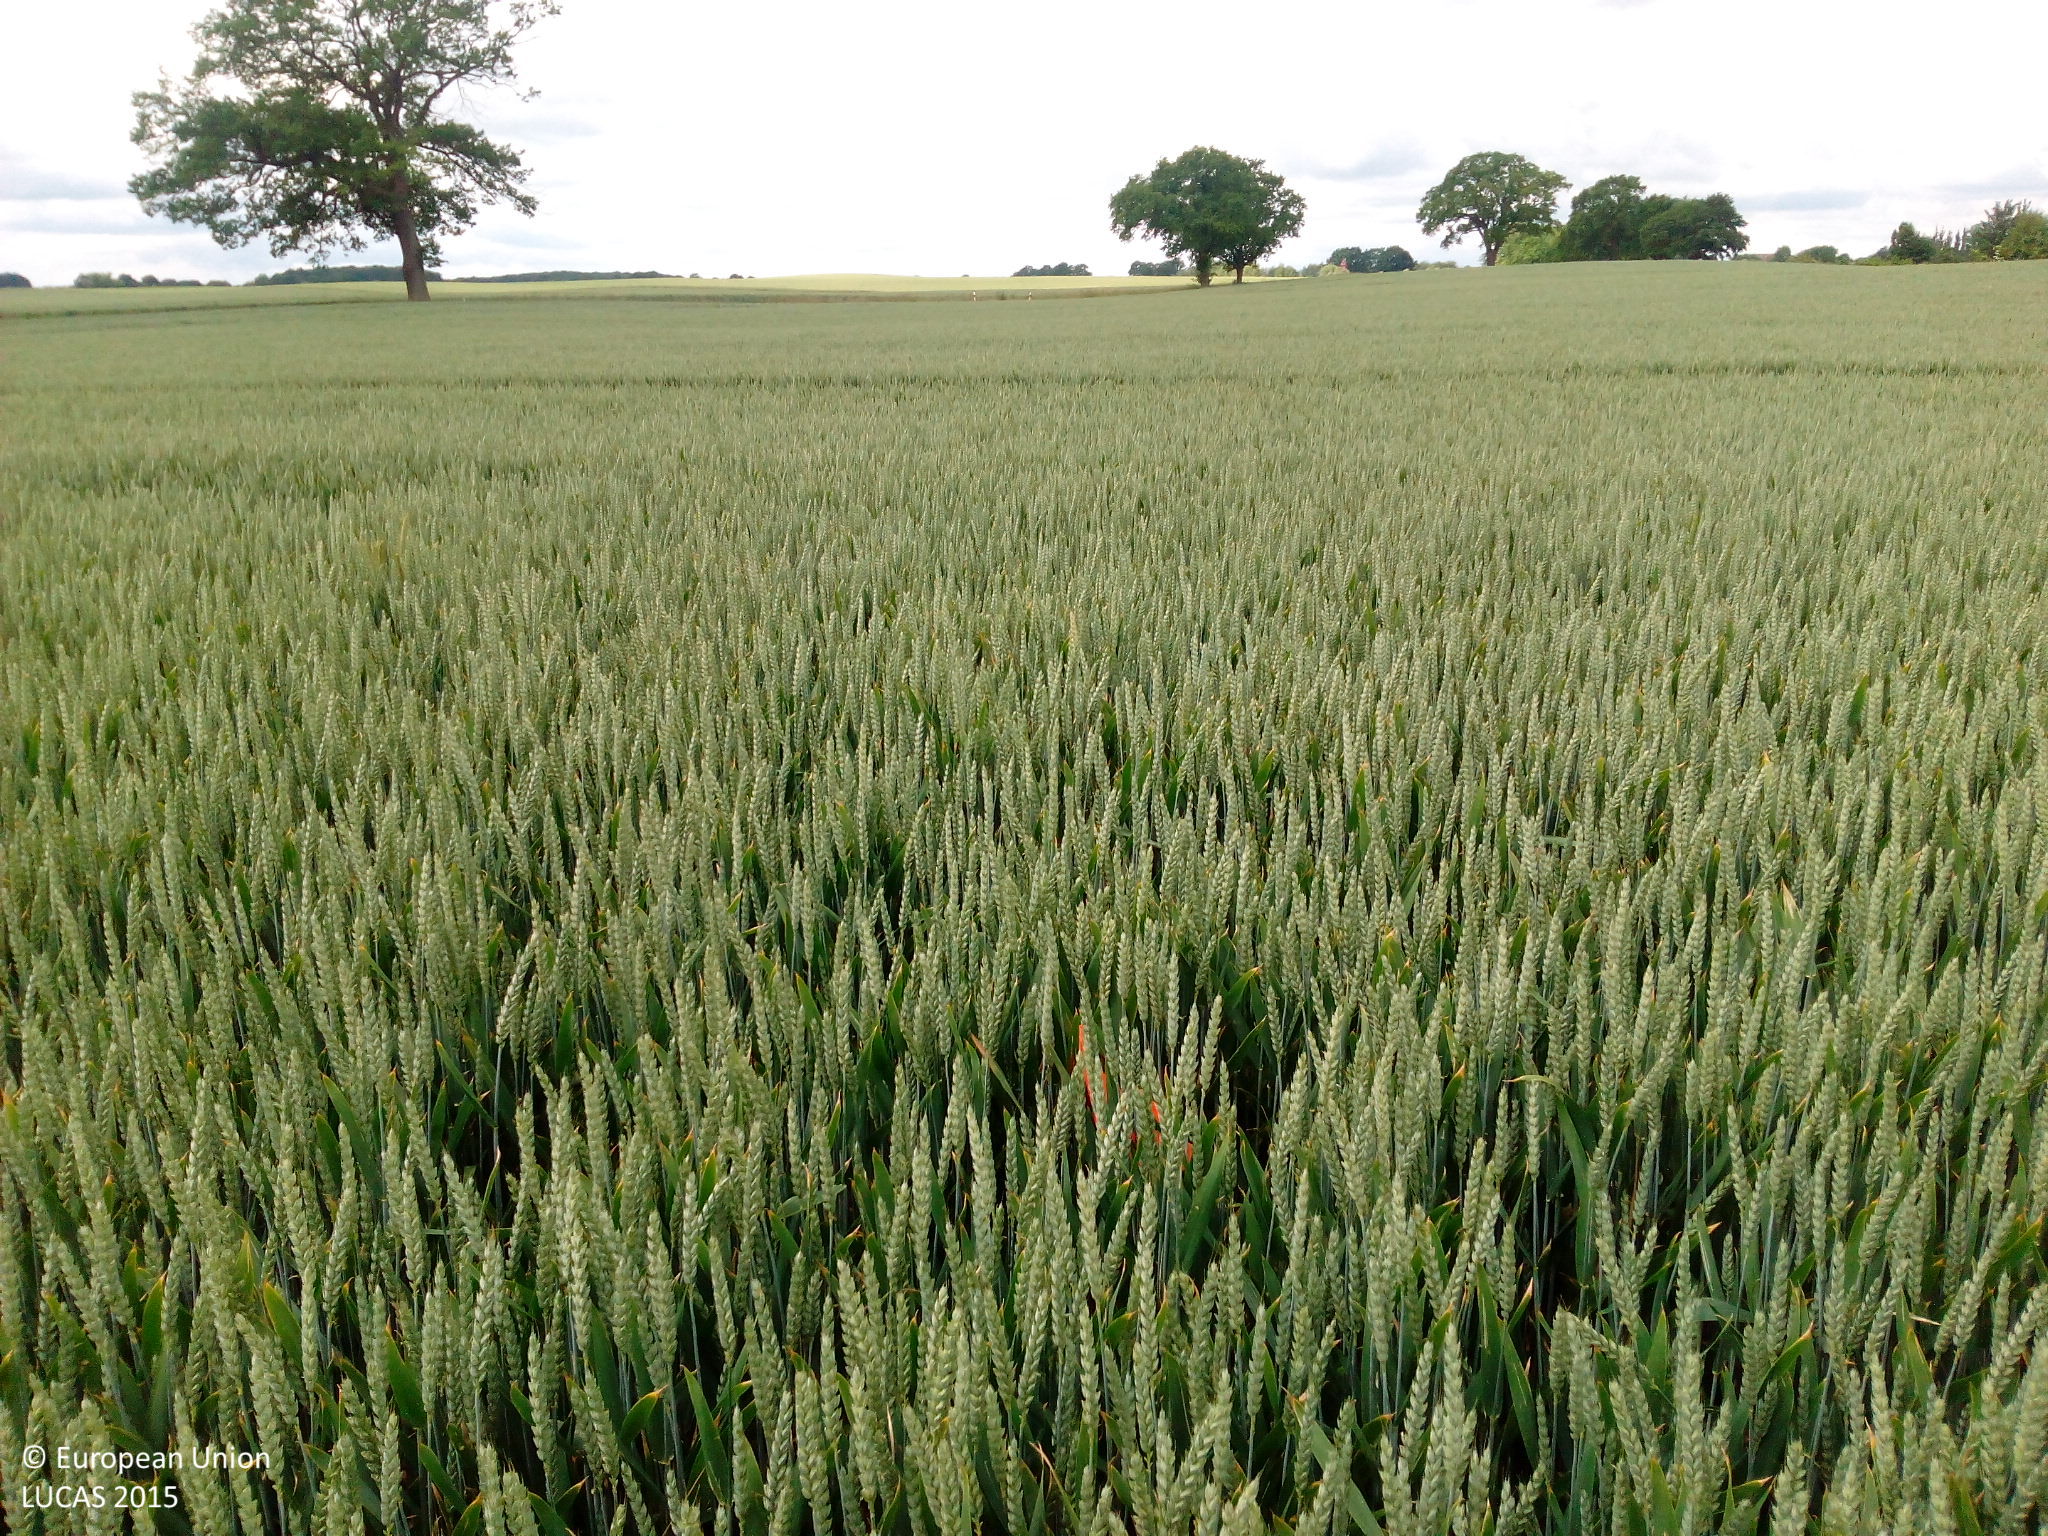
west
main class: Cropland
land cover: Common wheat
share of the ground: > 75 %
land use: Agriculture (excluding fallow land and kitchen gardens)
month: June
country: DE
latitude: 53.8100
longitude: 11.1384
